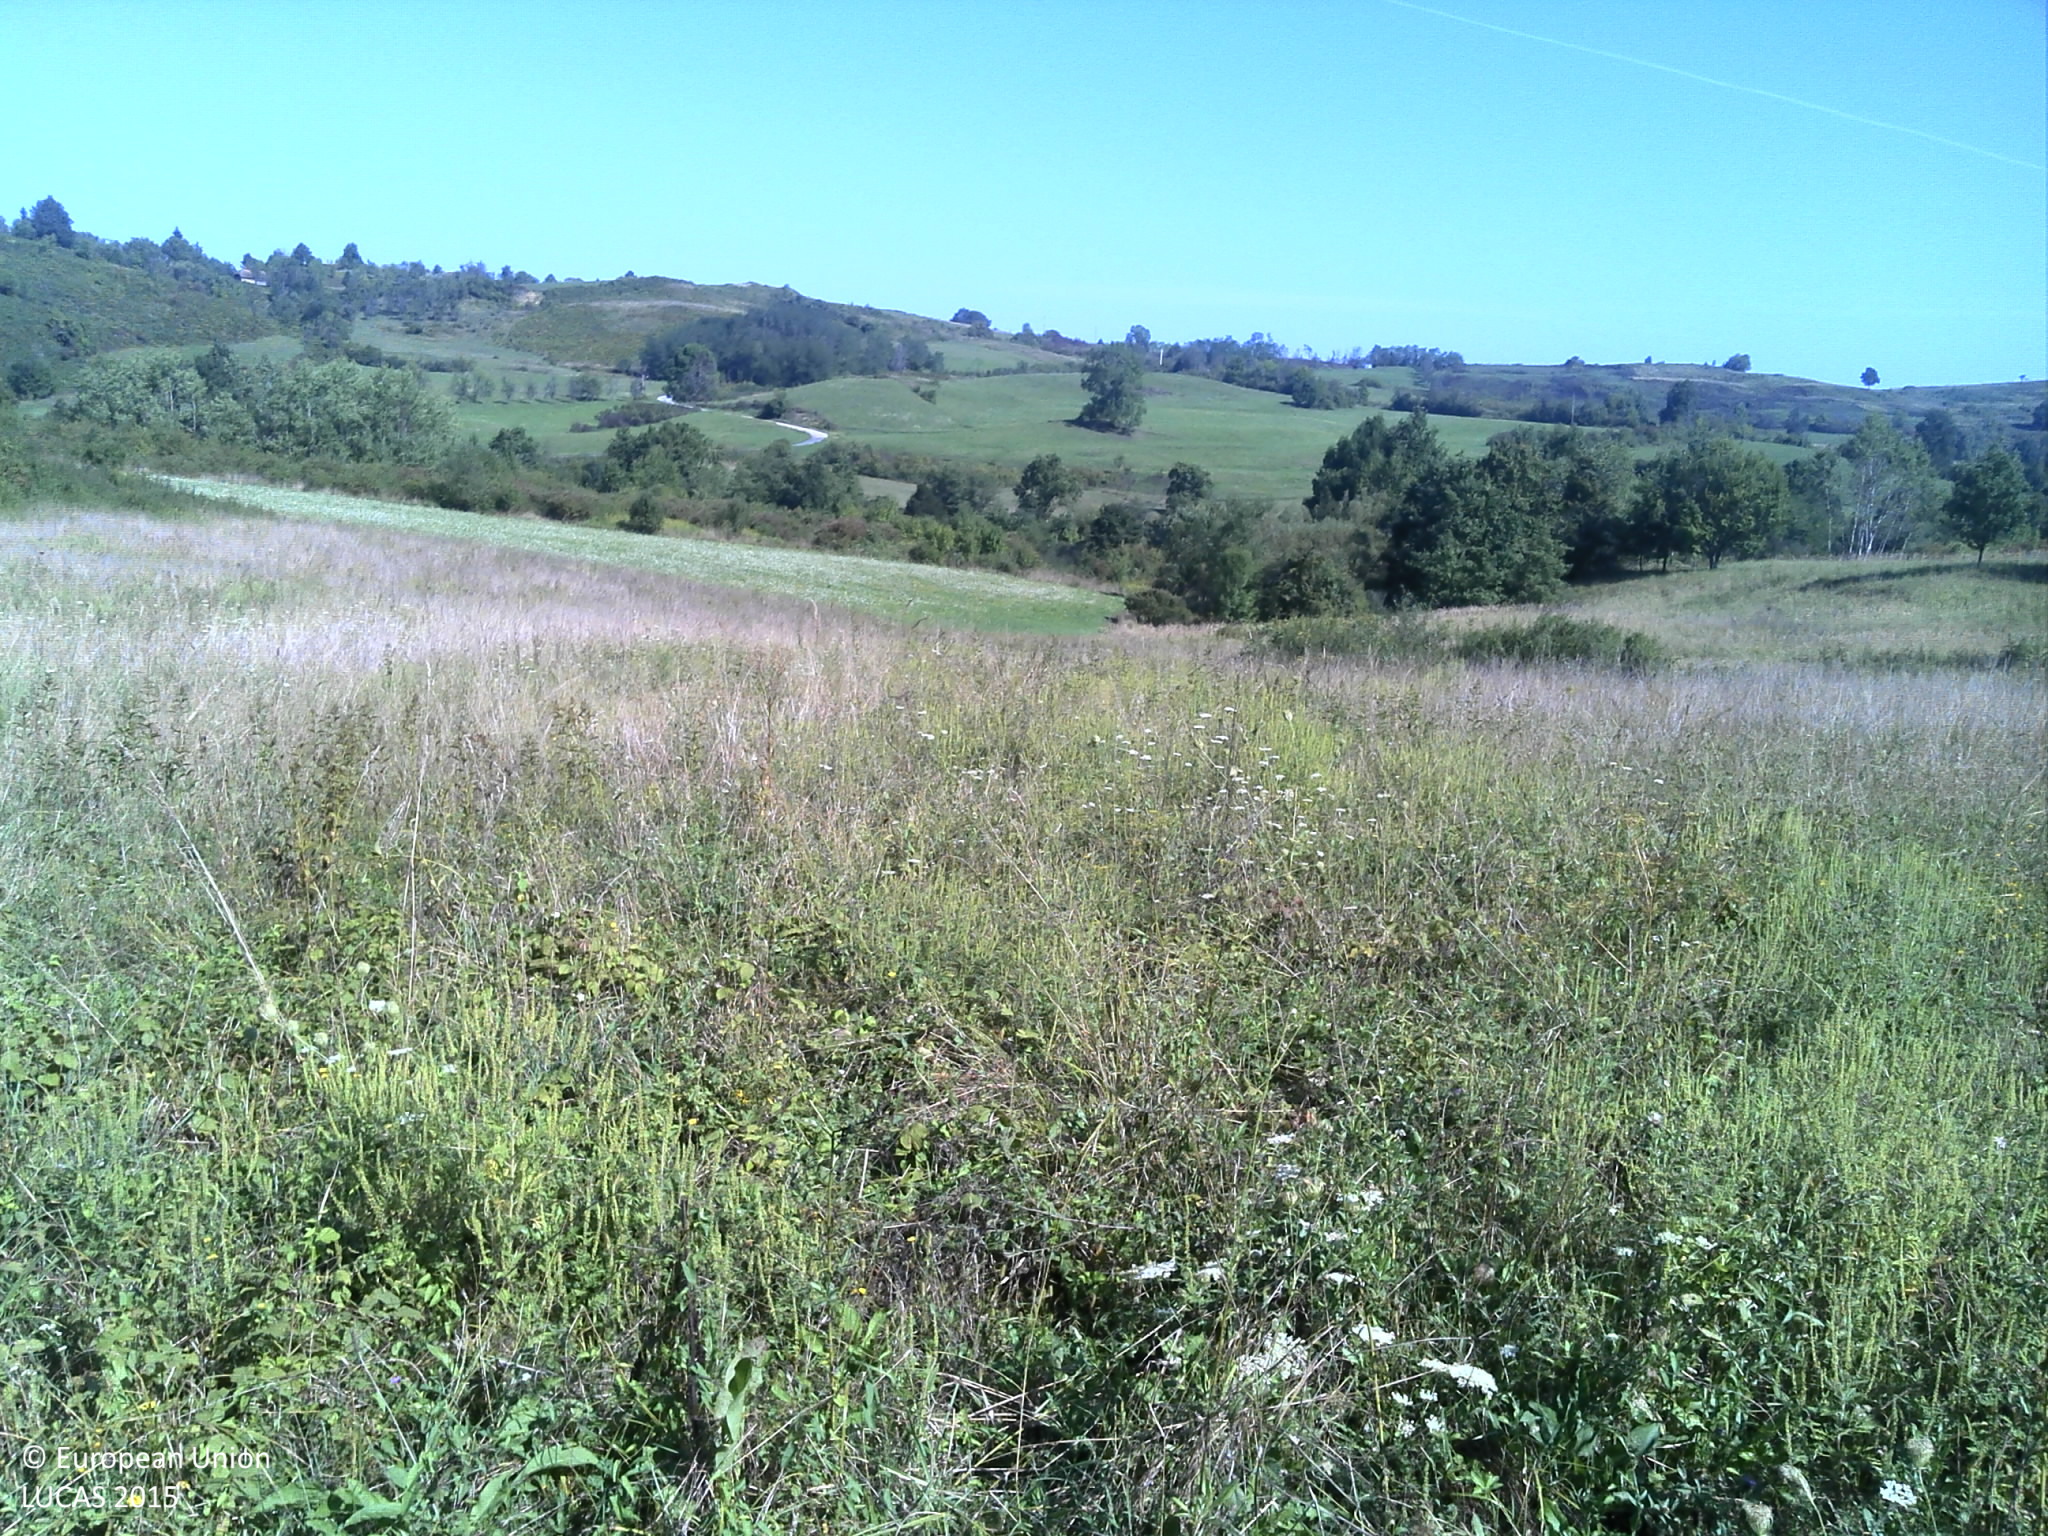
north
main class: Grassland
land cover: Spontaneously vegetated surfaces
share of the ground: > 75 %
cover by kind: herbaceous plants 100 %
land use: Semi-natural and natural areas not in use
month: August
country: HR
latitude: 45.2318
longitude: 16.1997
